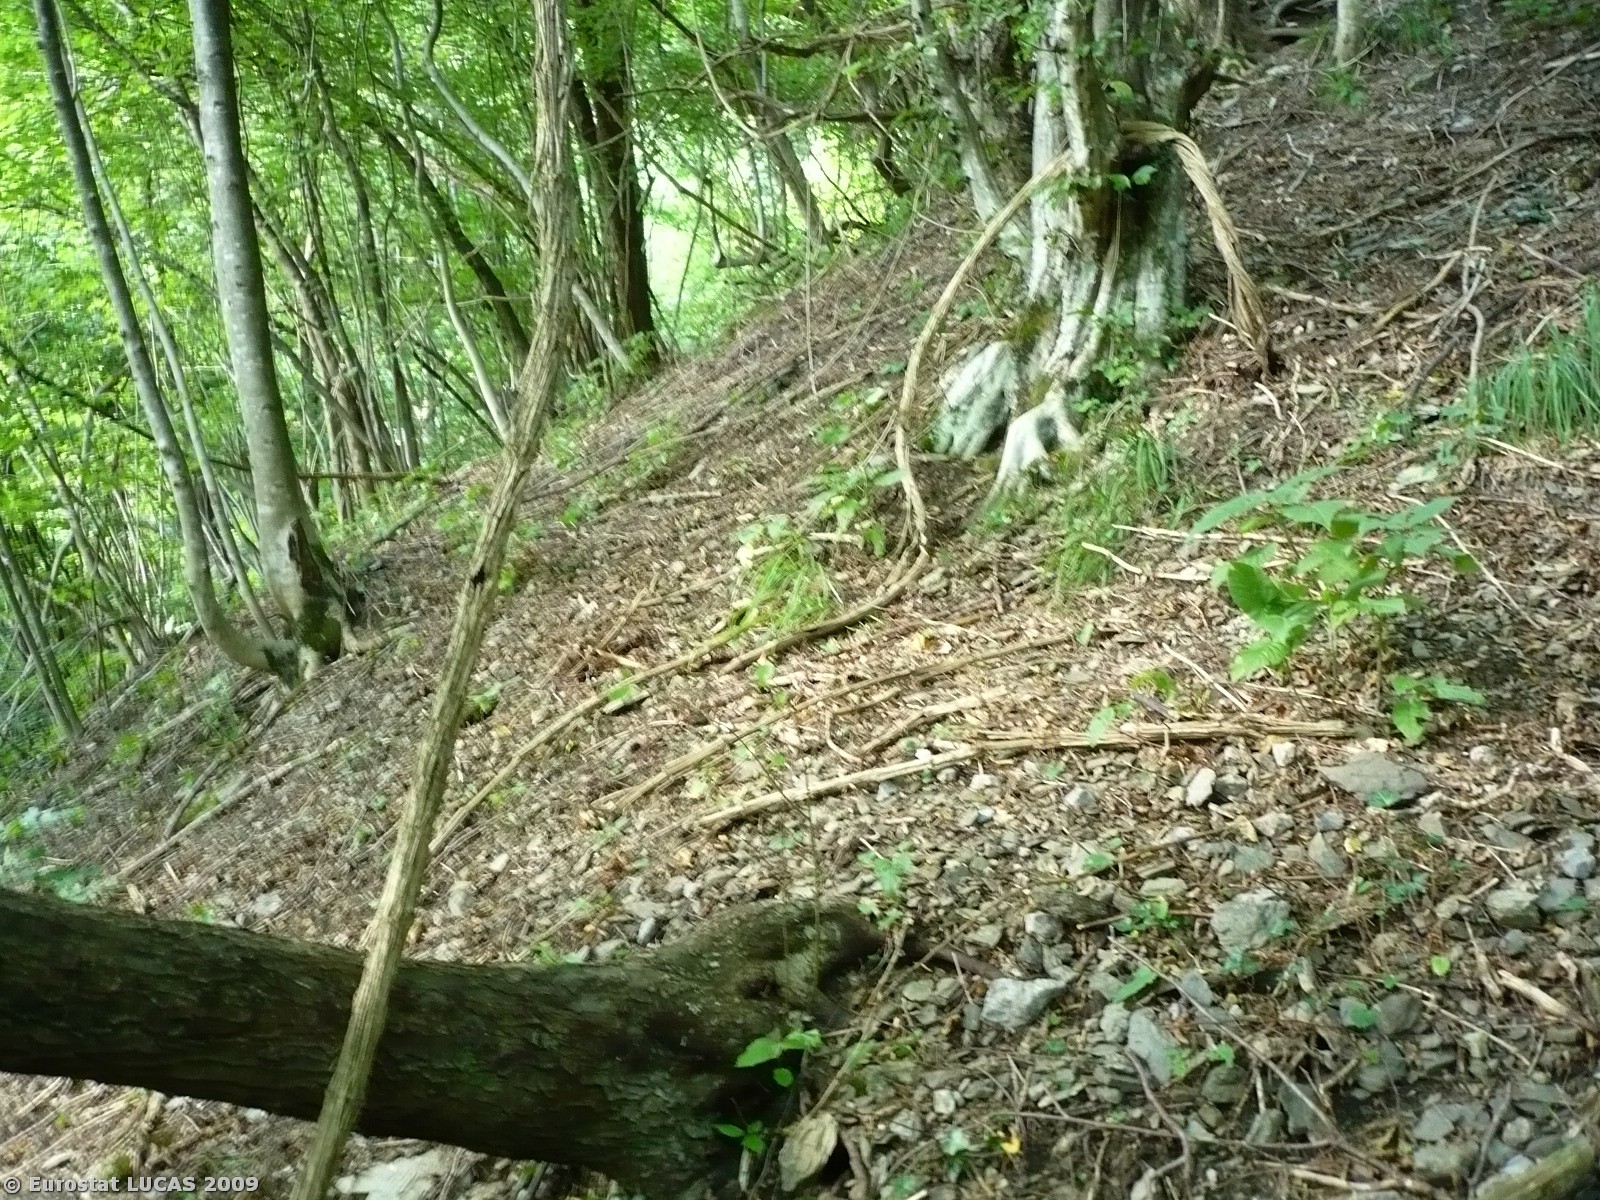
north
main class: Woodland
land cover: Broadleaved woodland
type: mesophytic deciduous forest
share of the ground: > 75 %
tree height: > 5 m
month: August
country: SI
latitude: 46.1615
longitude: 13.6873
